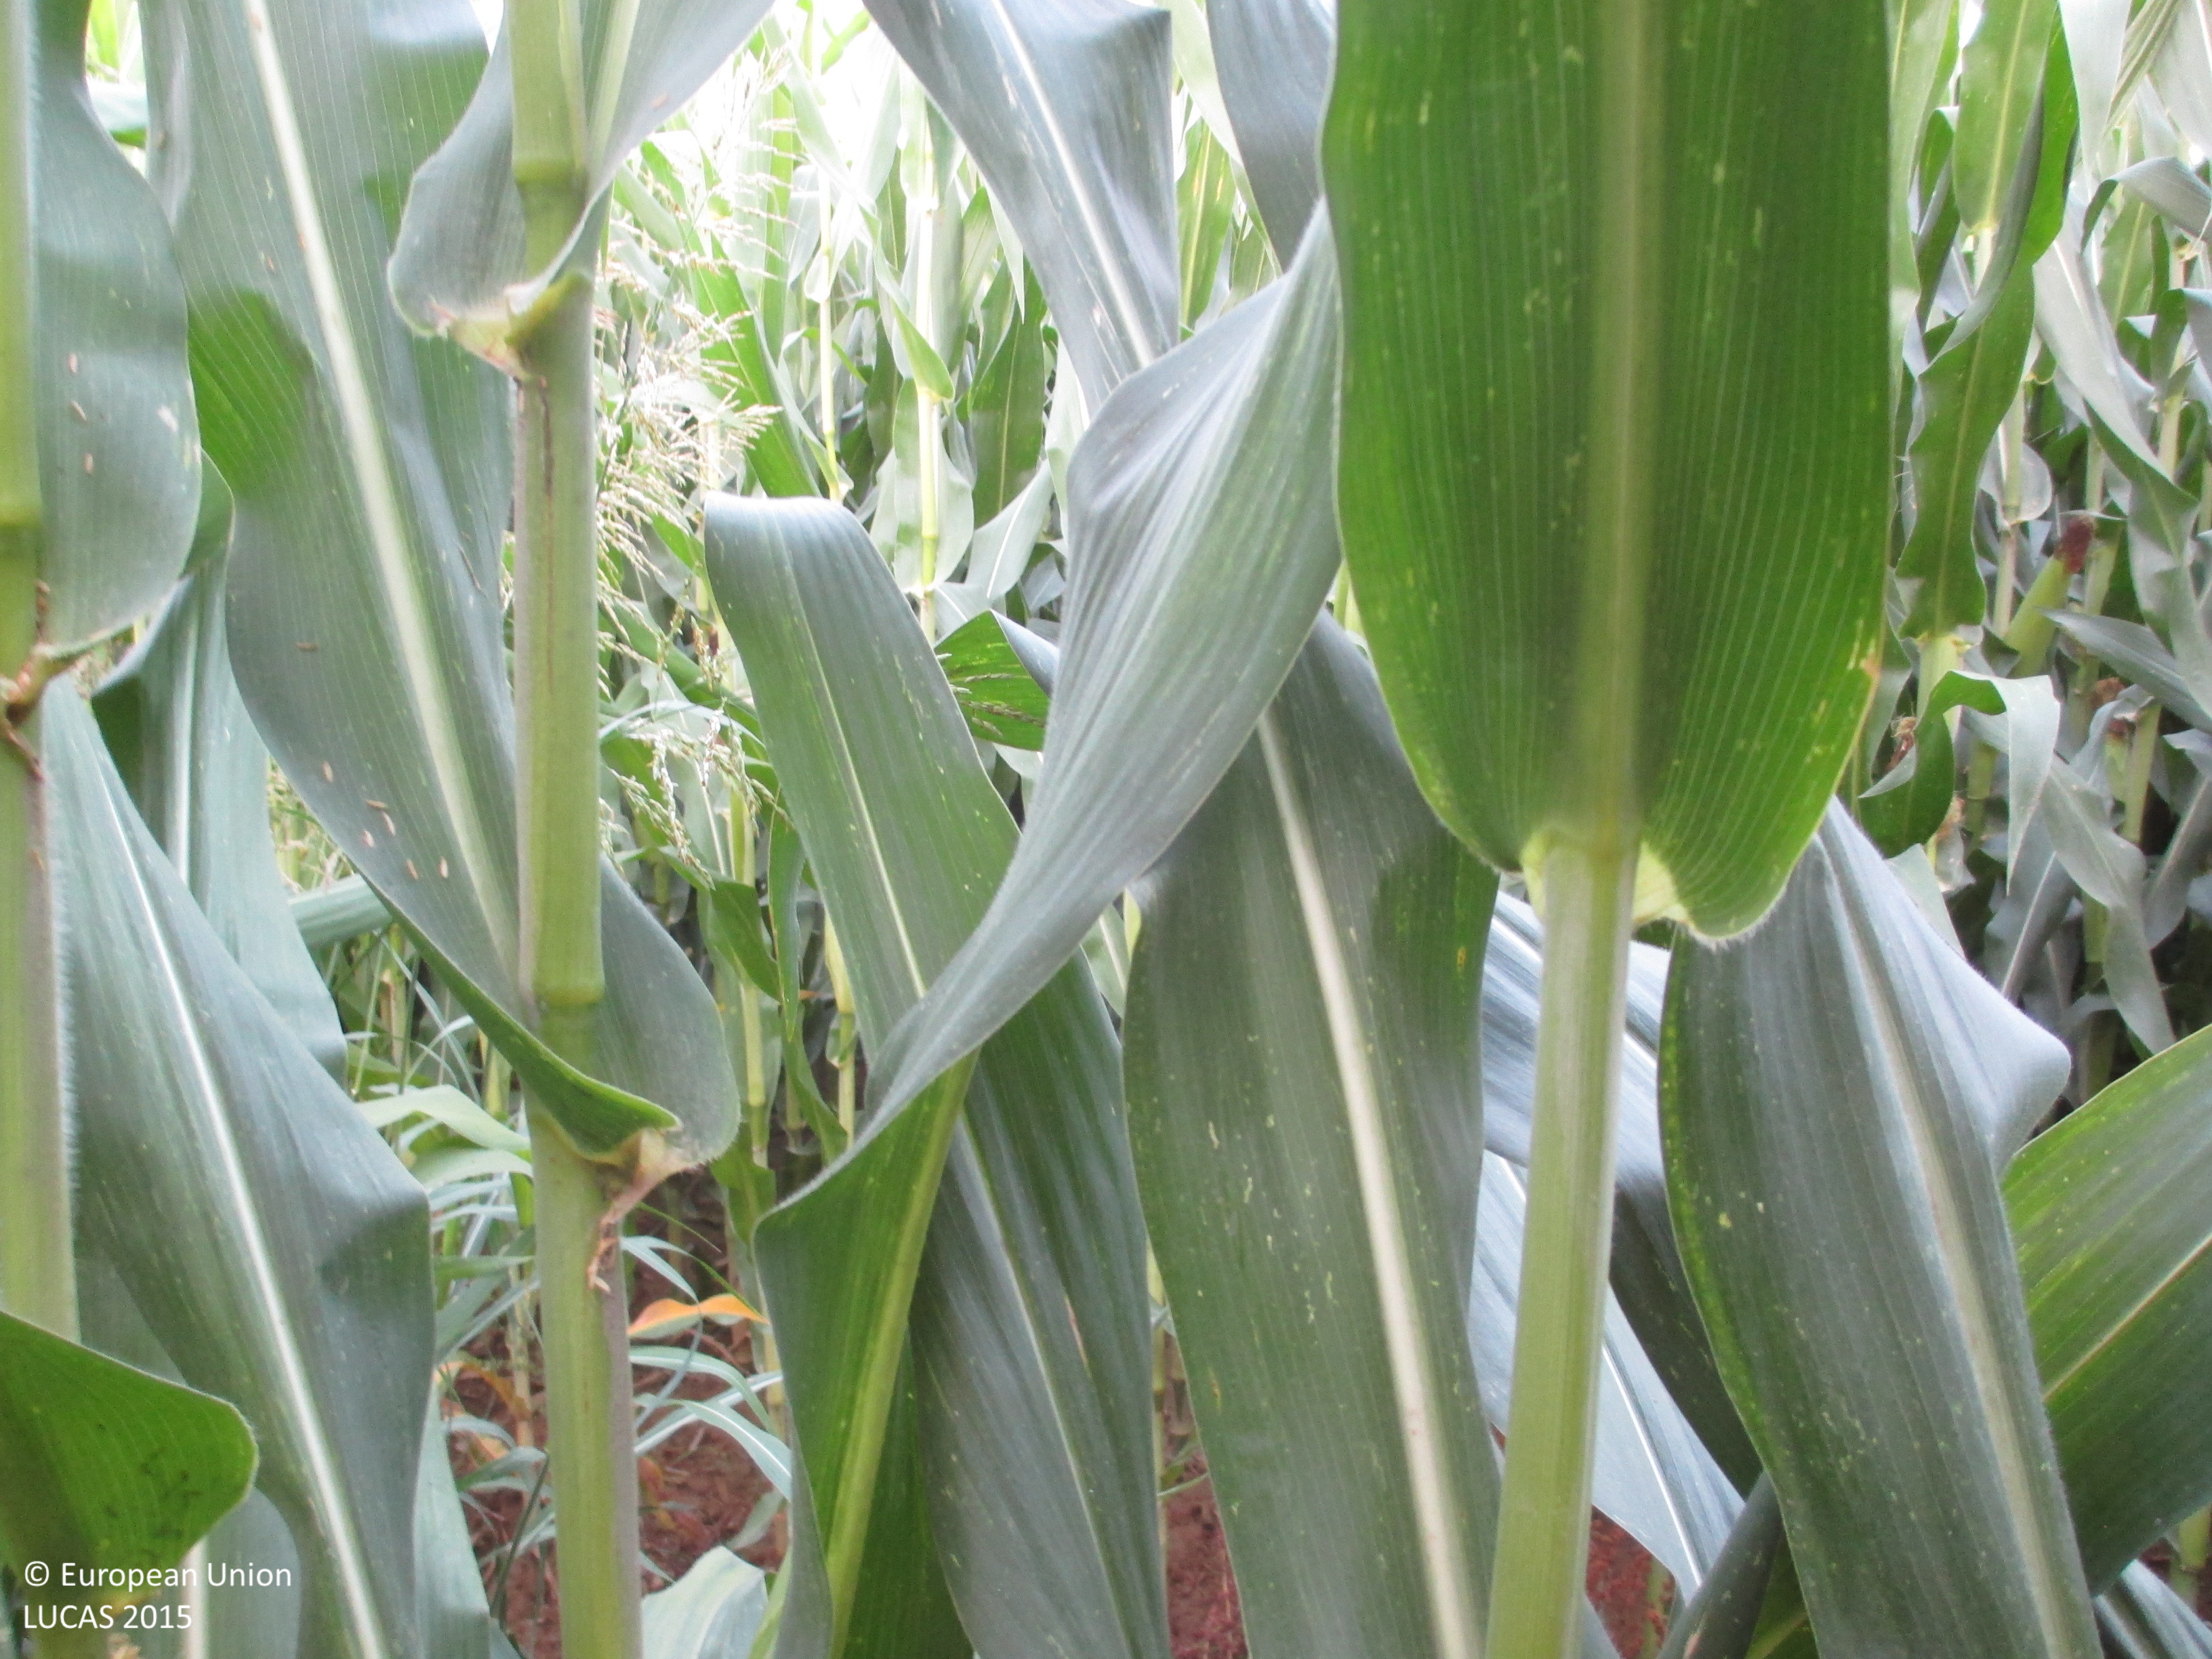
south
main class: Cropland
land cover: Maize
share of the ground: > 75 %
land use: Agriculture (excluding fallow land and kitchen gardens)
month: July
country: ES
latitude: 41.8456
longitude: 0.3374
